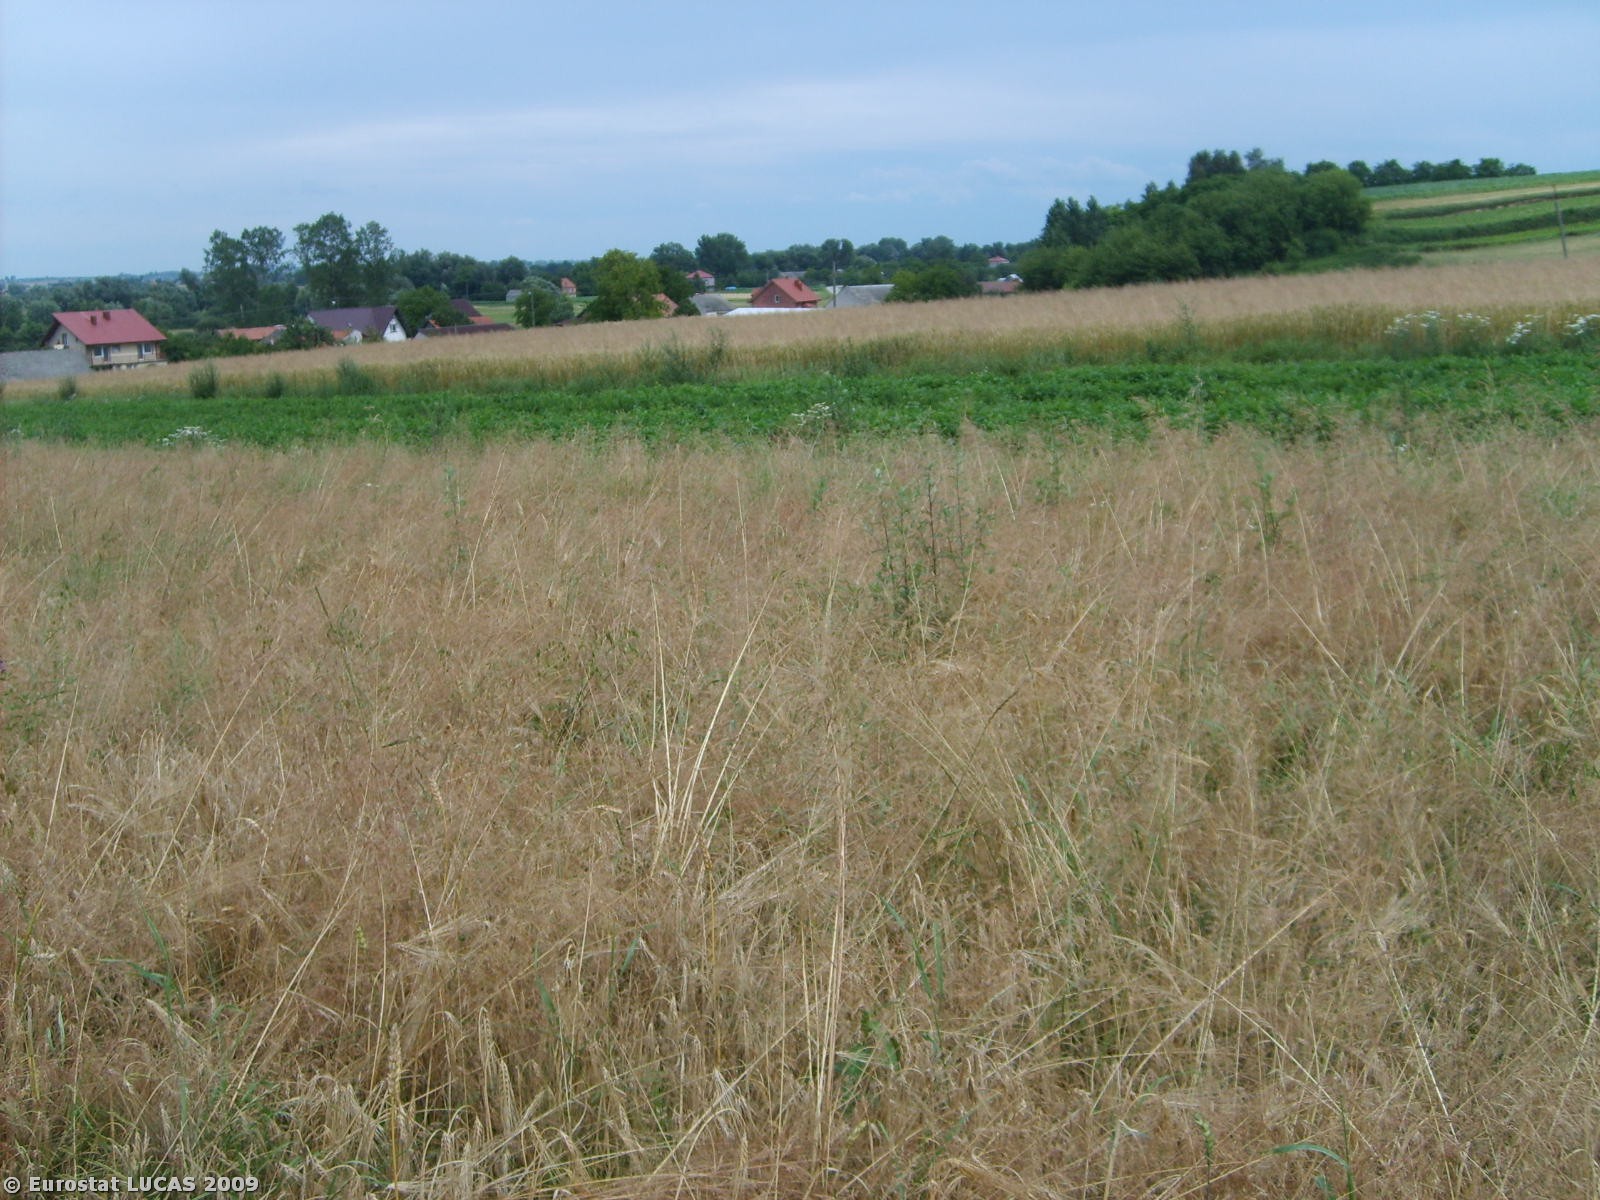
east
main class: Cropland
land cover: Barley
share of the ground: > 75 %
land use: Agriculture (excluding fallow land and kitchen gardens)
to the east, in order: Barley; Grass margins; Other fresh vegetables; Grass margins; Common wheat; Grass margins; Common wheat; Potatoes; Other fresh vegetables; Grass margins; Rye; Grass margins; Electric lines; Common wheat; Artificial constructions in urban areas
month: July
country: PL
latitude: 50.3169
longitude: 20.6711
